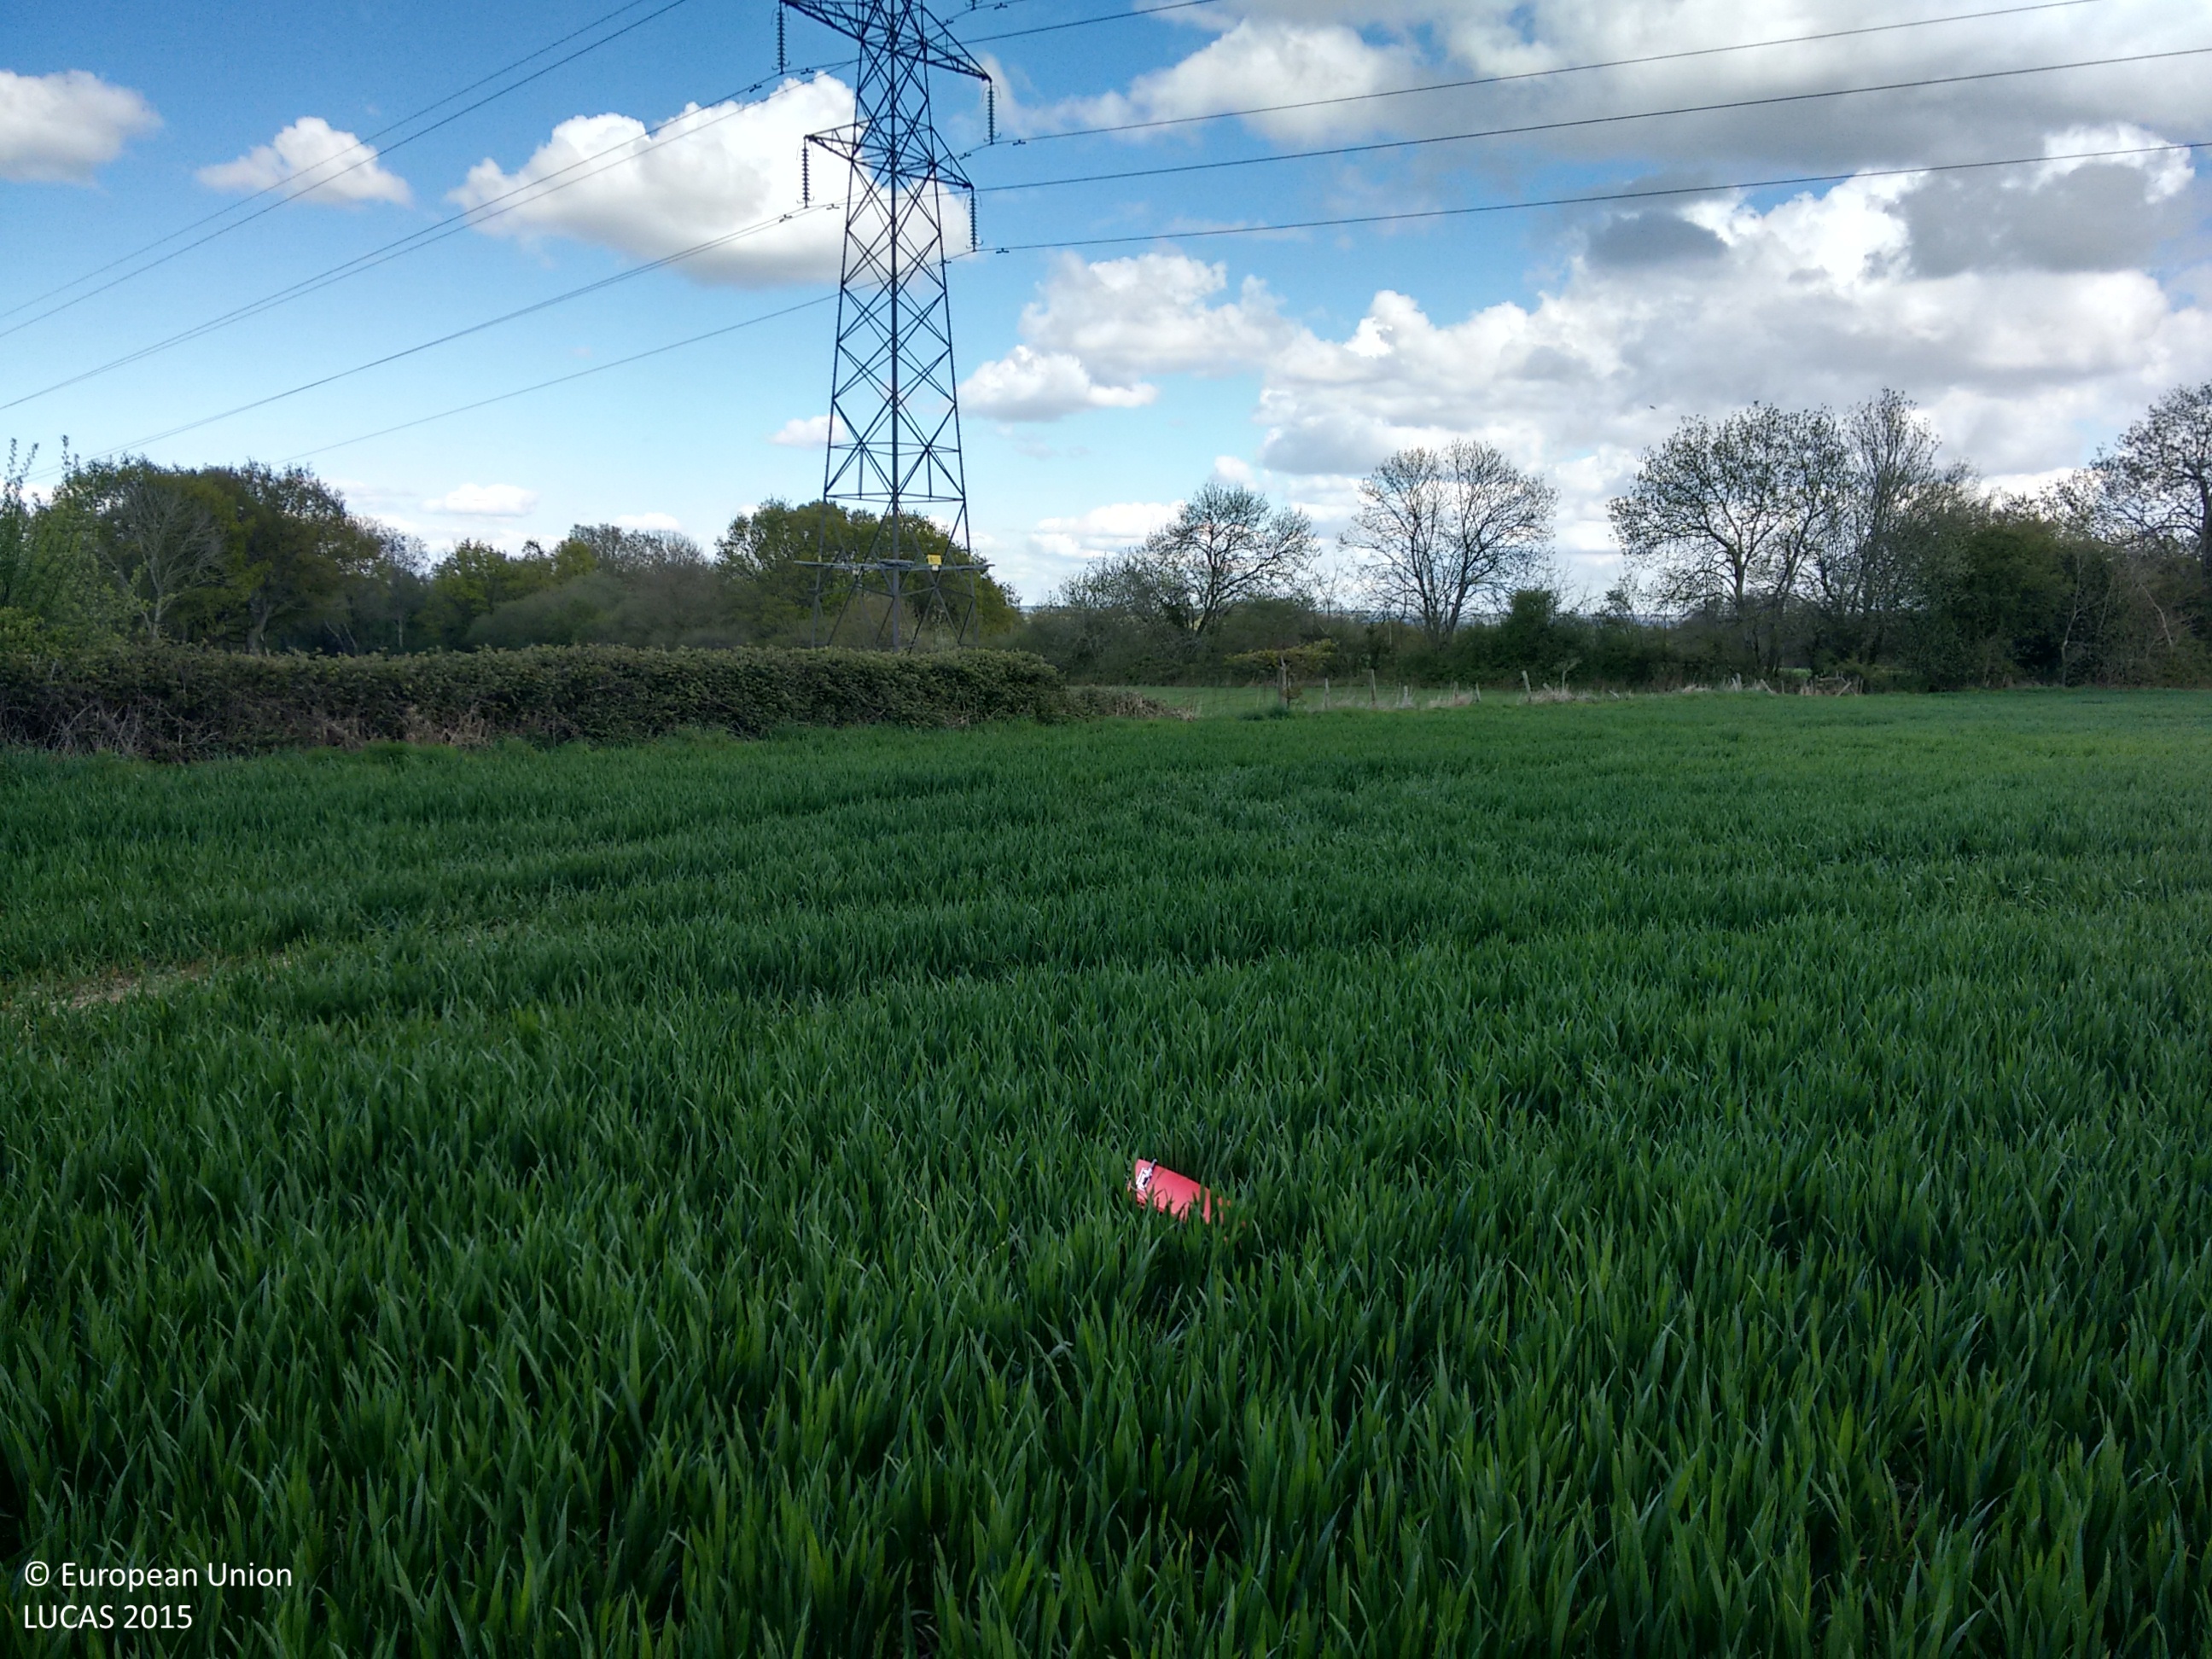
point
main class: Cropland
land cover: Common wheat
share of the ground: > 75 %
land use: Agriculture (excluding fallow land and kitchen gardens)
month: April
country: GB
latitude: 50.9241
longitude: -1.8786
